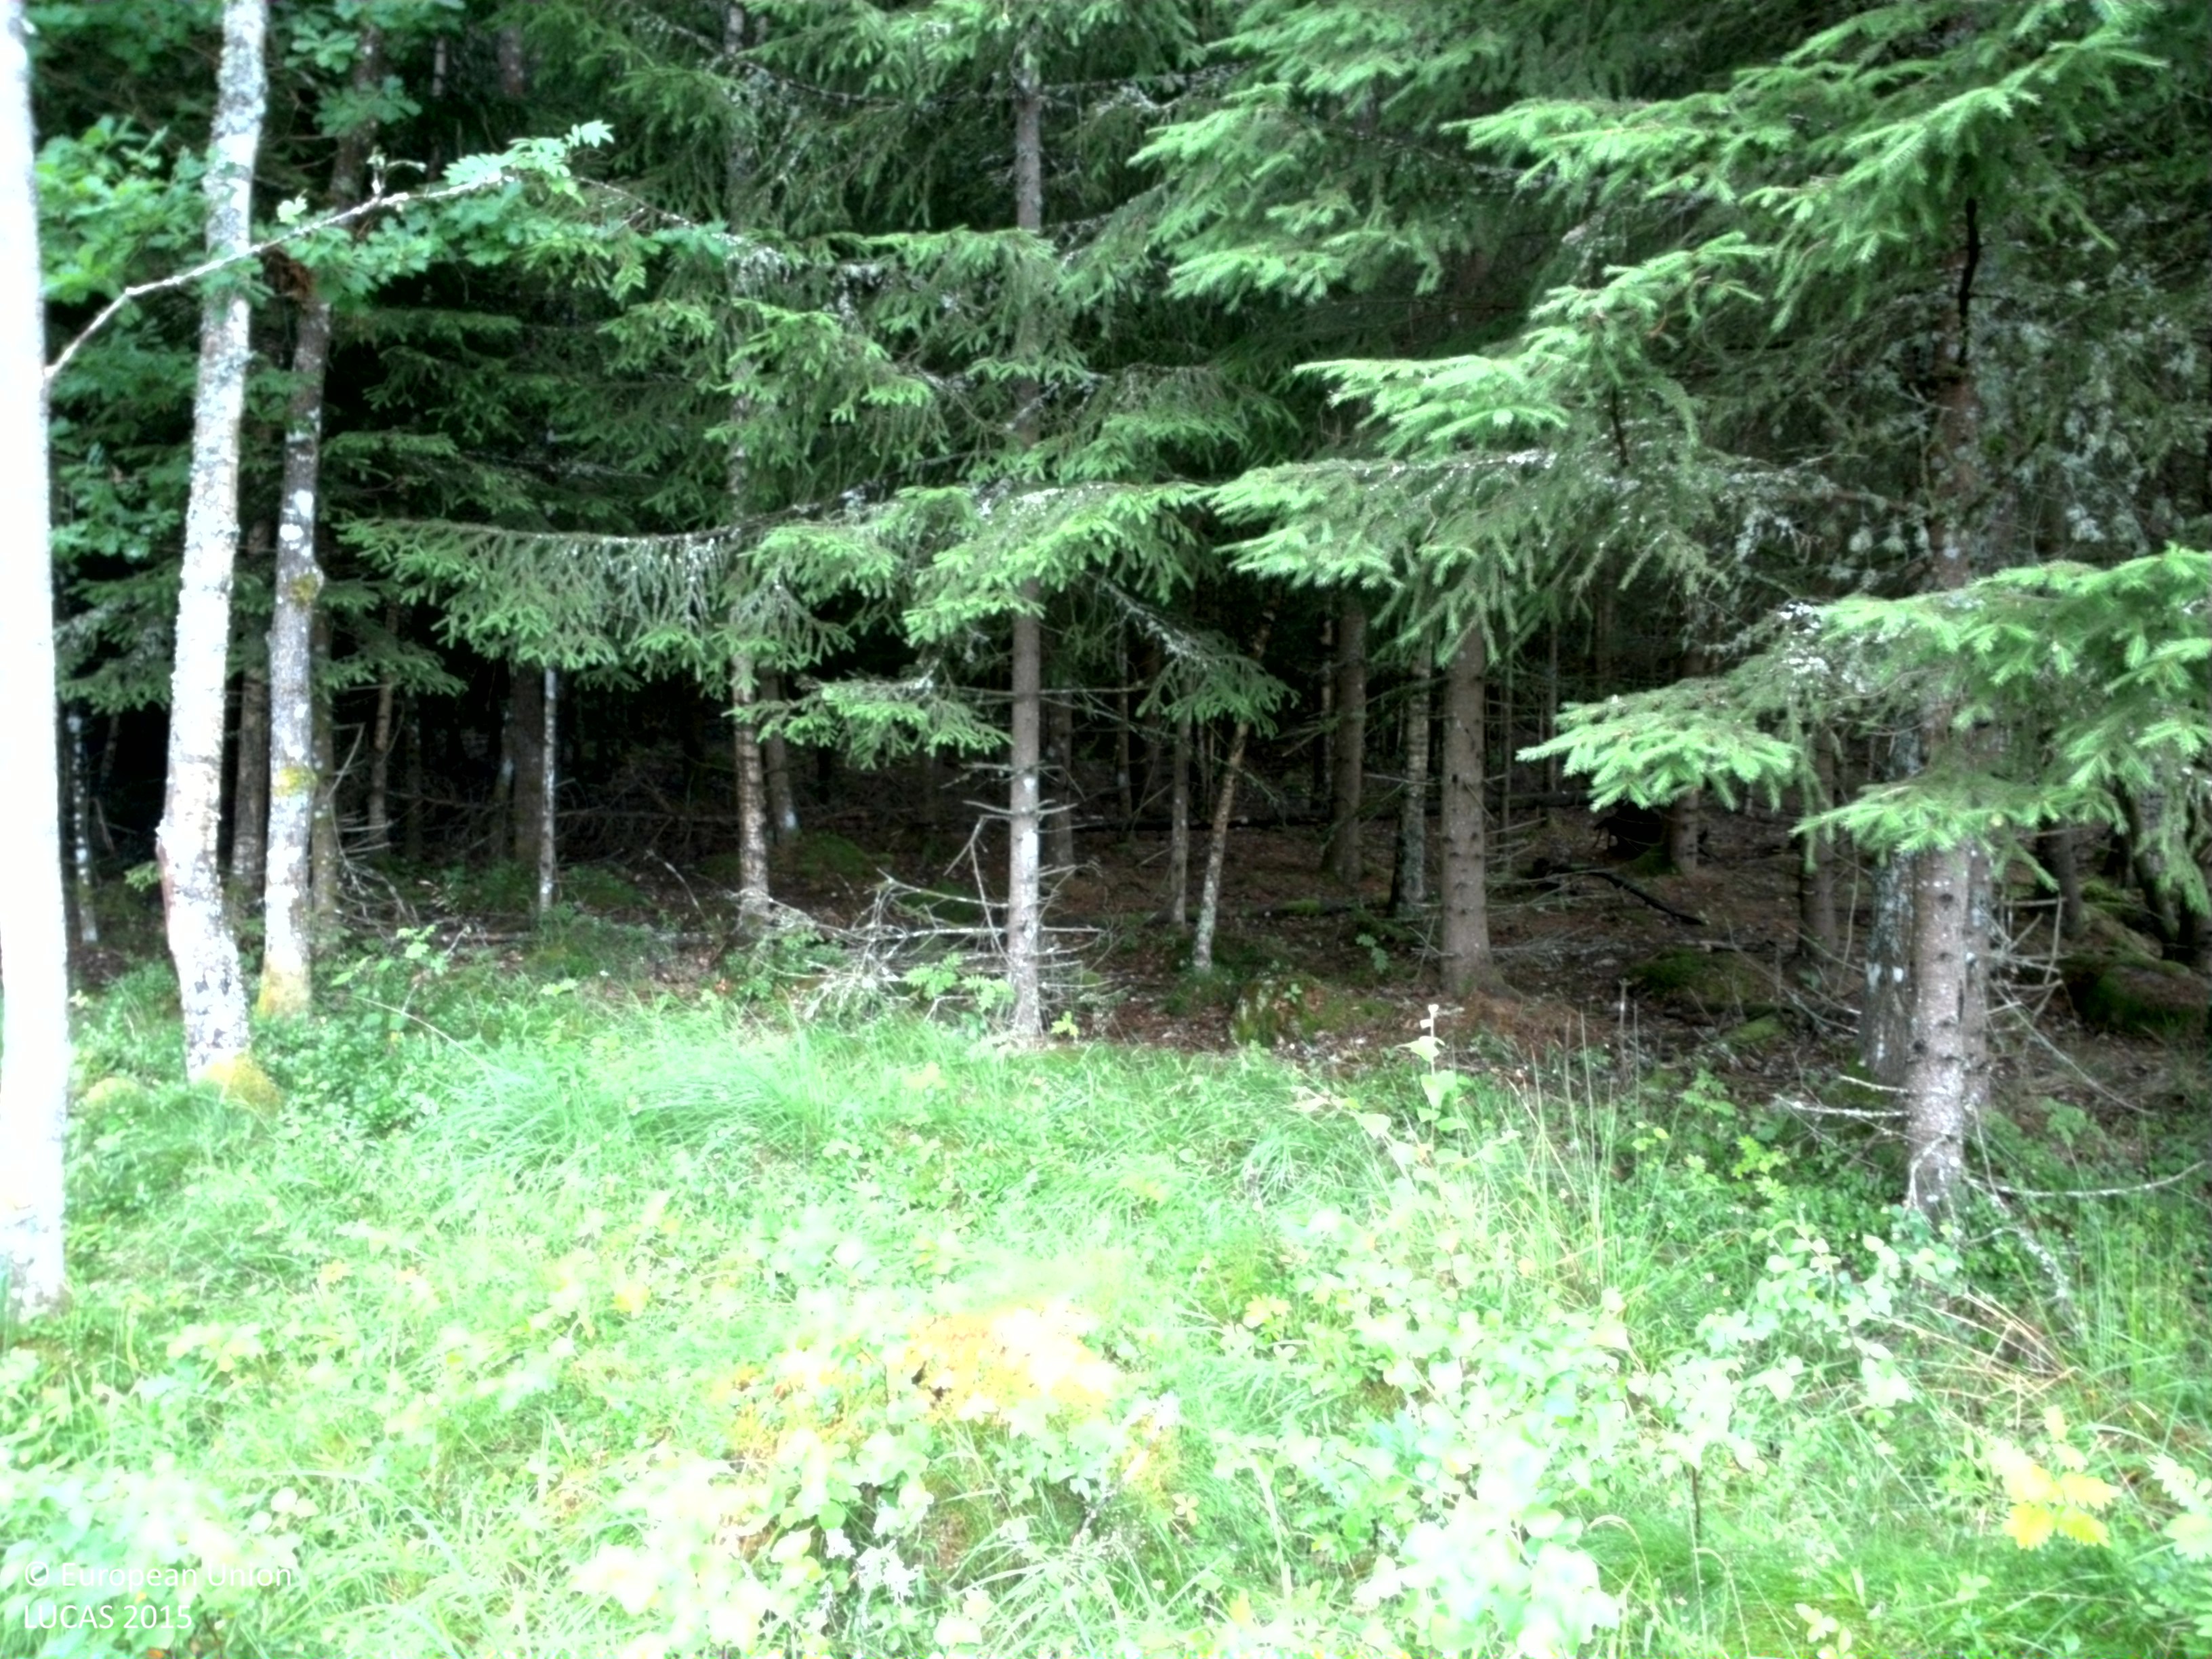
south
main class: Woodland
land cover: Broadleaved woodland
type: boreal forest
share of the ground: 50 - 75 %
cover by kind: broadleaved forest trees 70 %, herbaceous plants 20 %, coniferous forest trees 5 %, shrubs 5 %
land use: Forestry
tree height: > 5 m
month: July
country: SE
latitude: 58.3225
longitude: 13.3236
